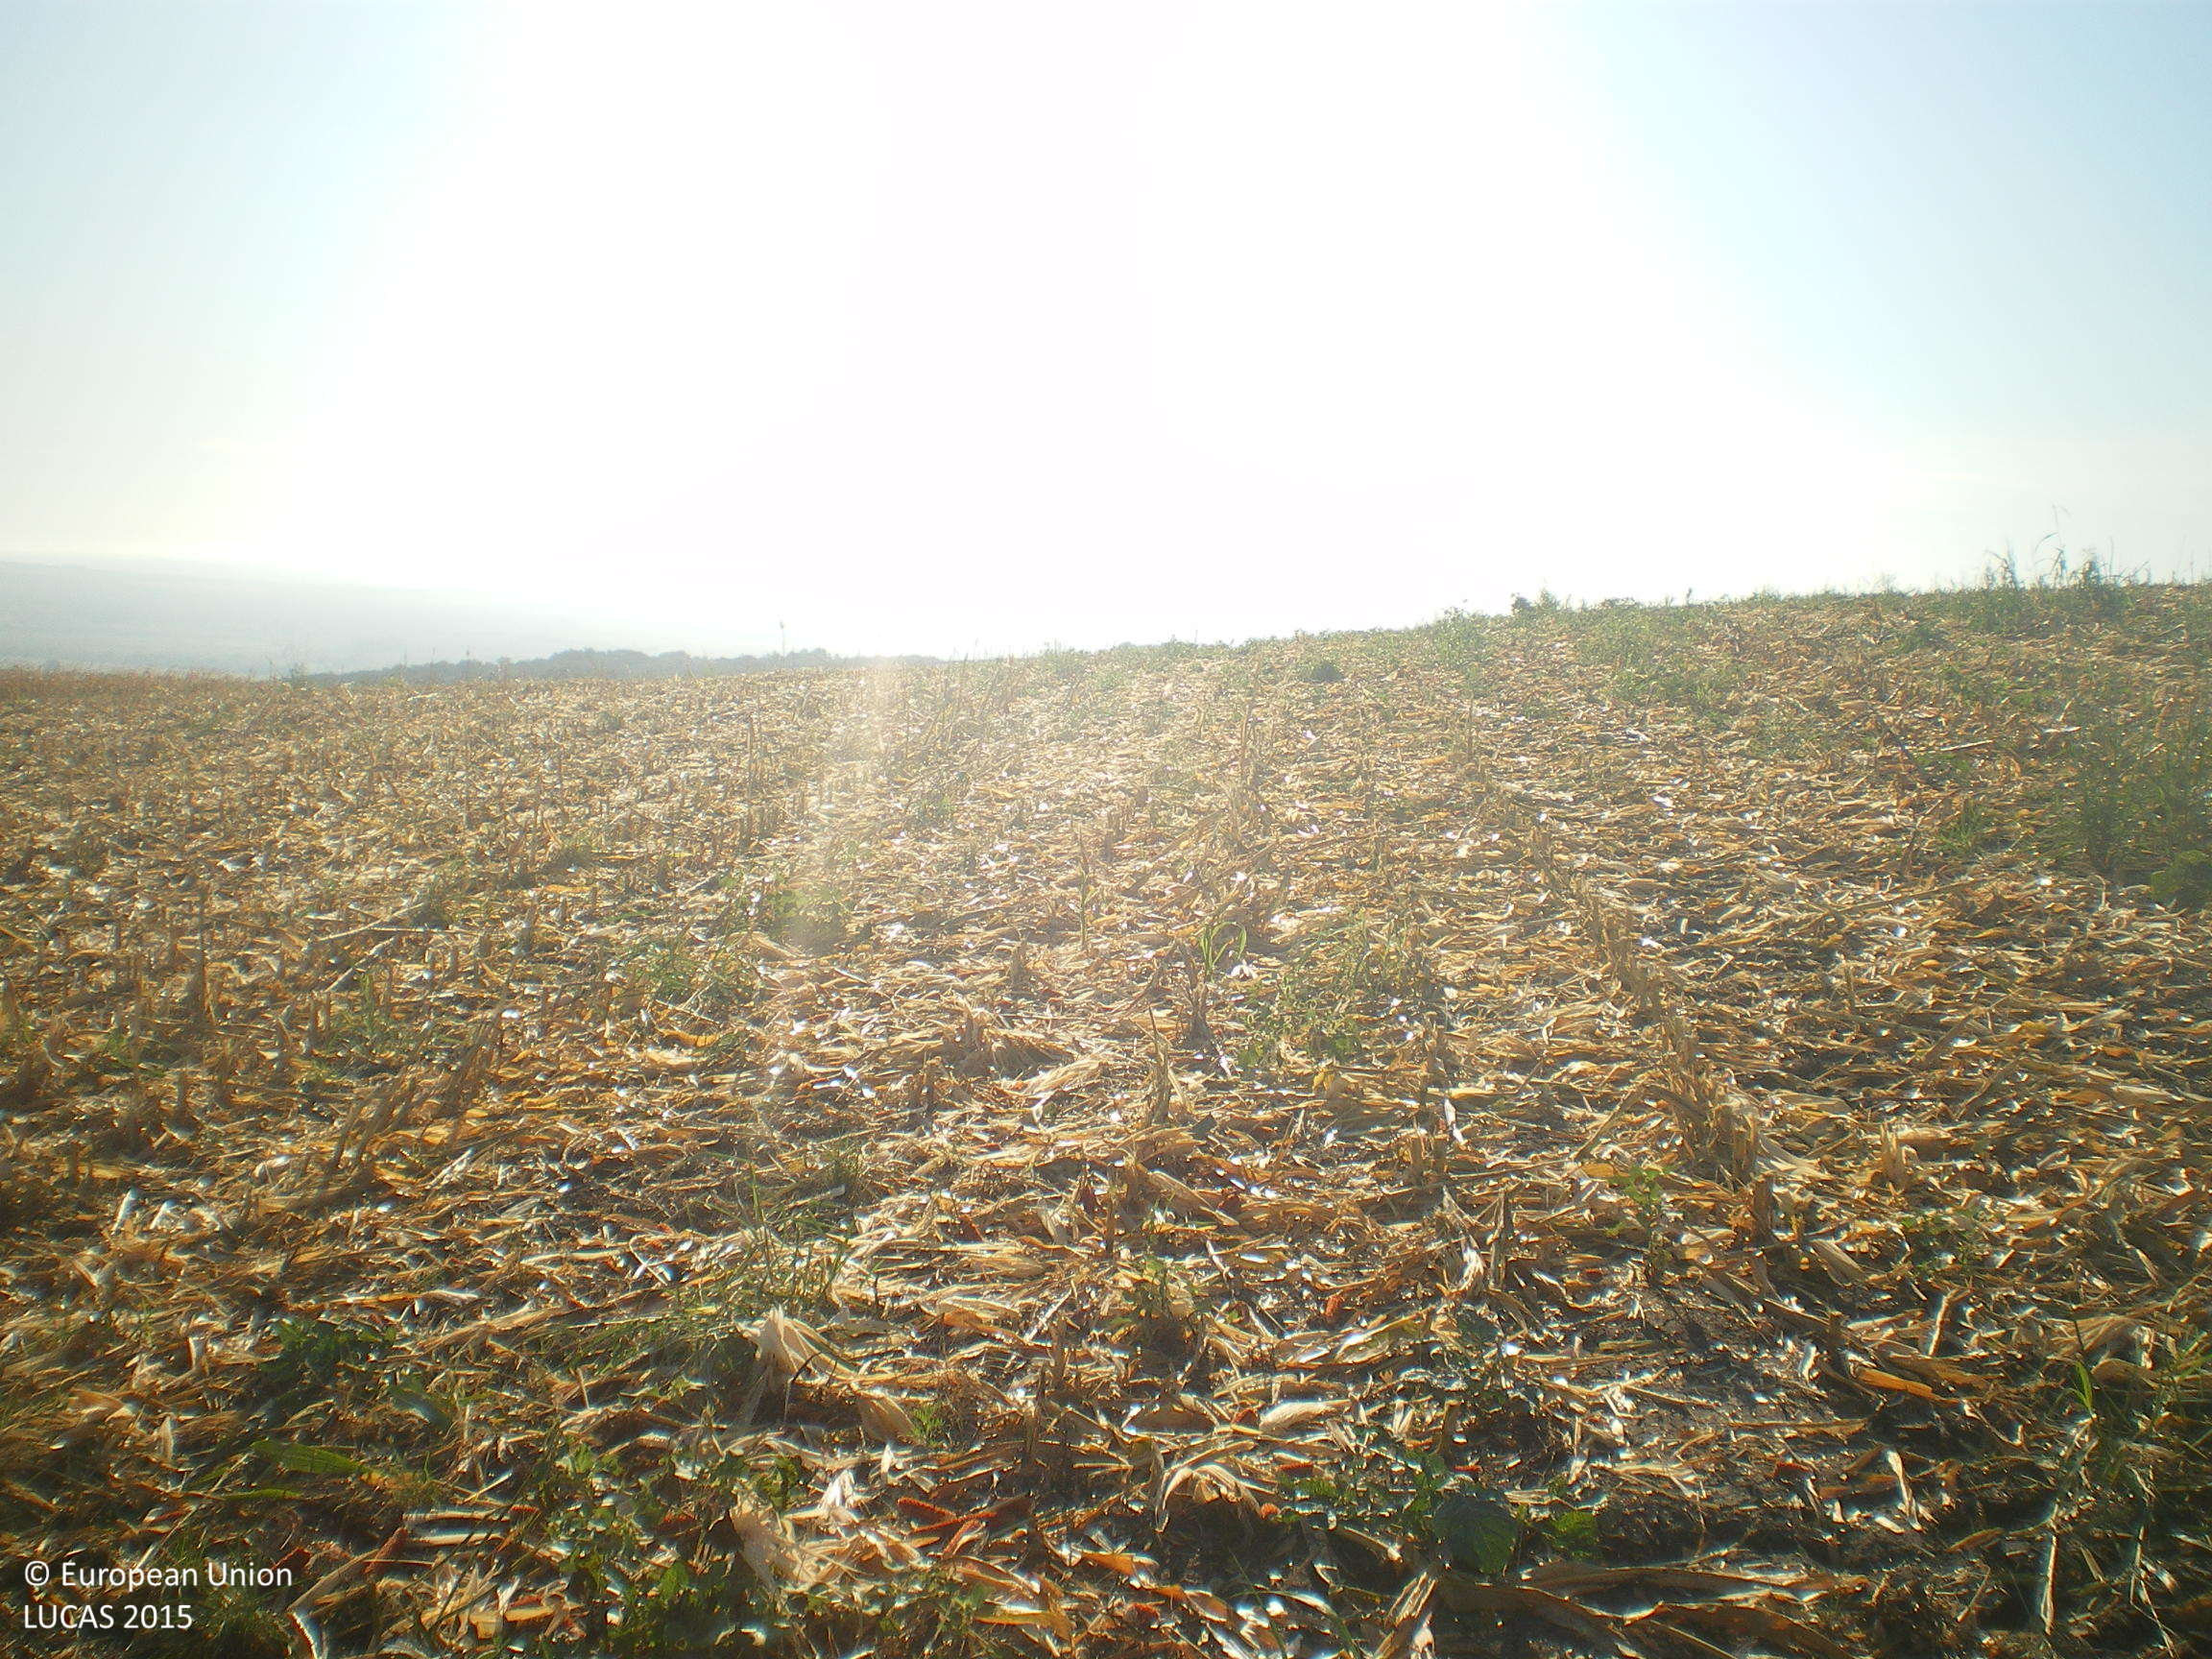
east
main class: Cropland
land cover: Maize
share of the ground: 10 - 25 %
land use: Agriculture (excluding fallow land and kitchen gardens)
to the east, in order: Maize; Grassland with sparse tree/shrub cover; Shrubland without tree cover
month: September
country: BG
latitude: 42.0770
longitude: 25.8462
